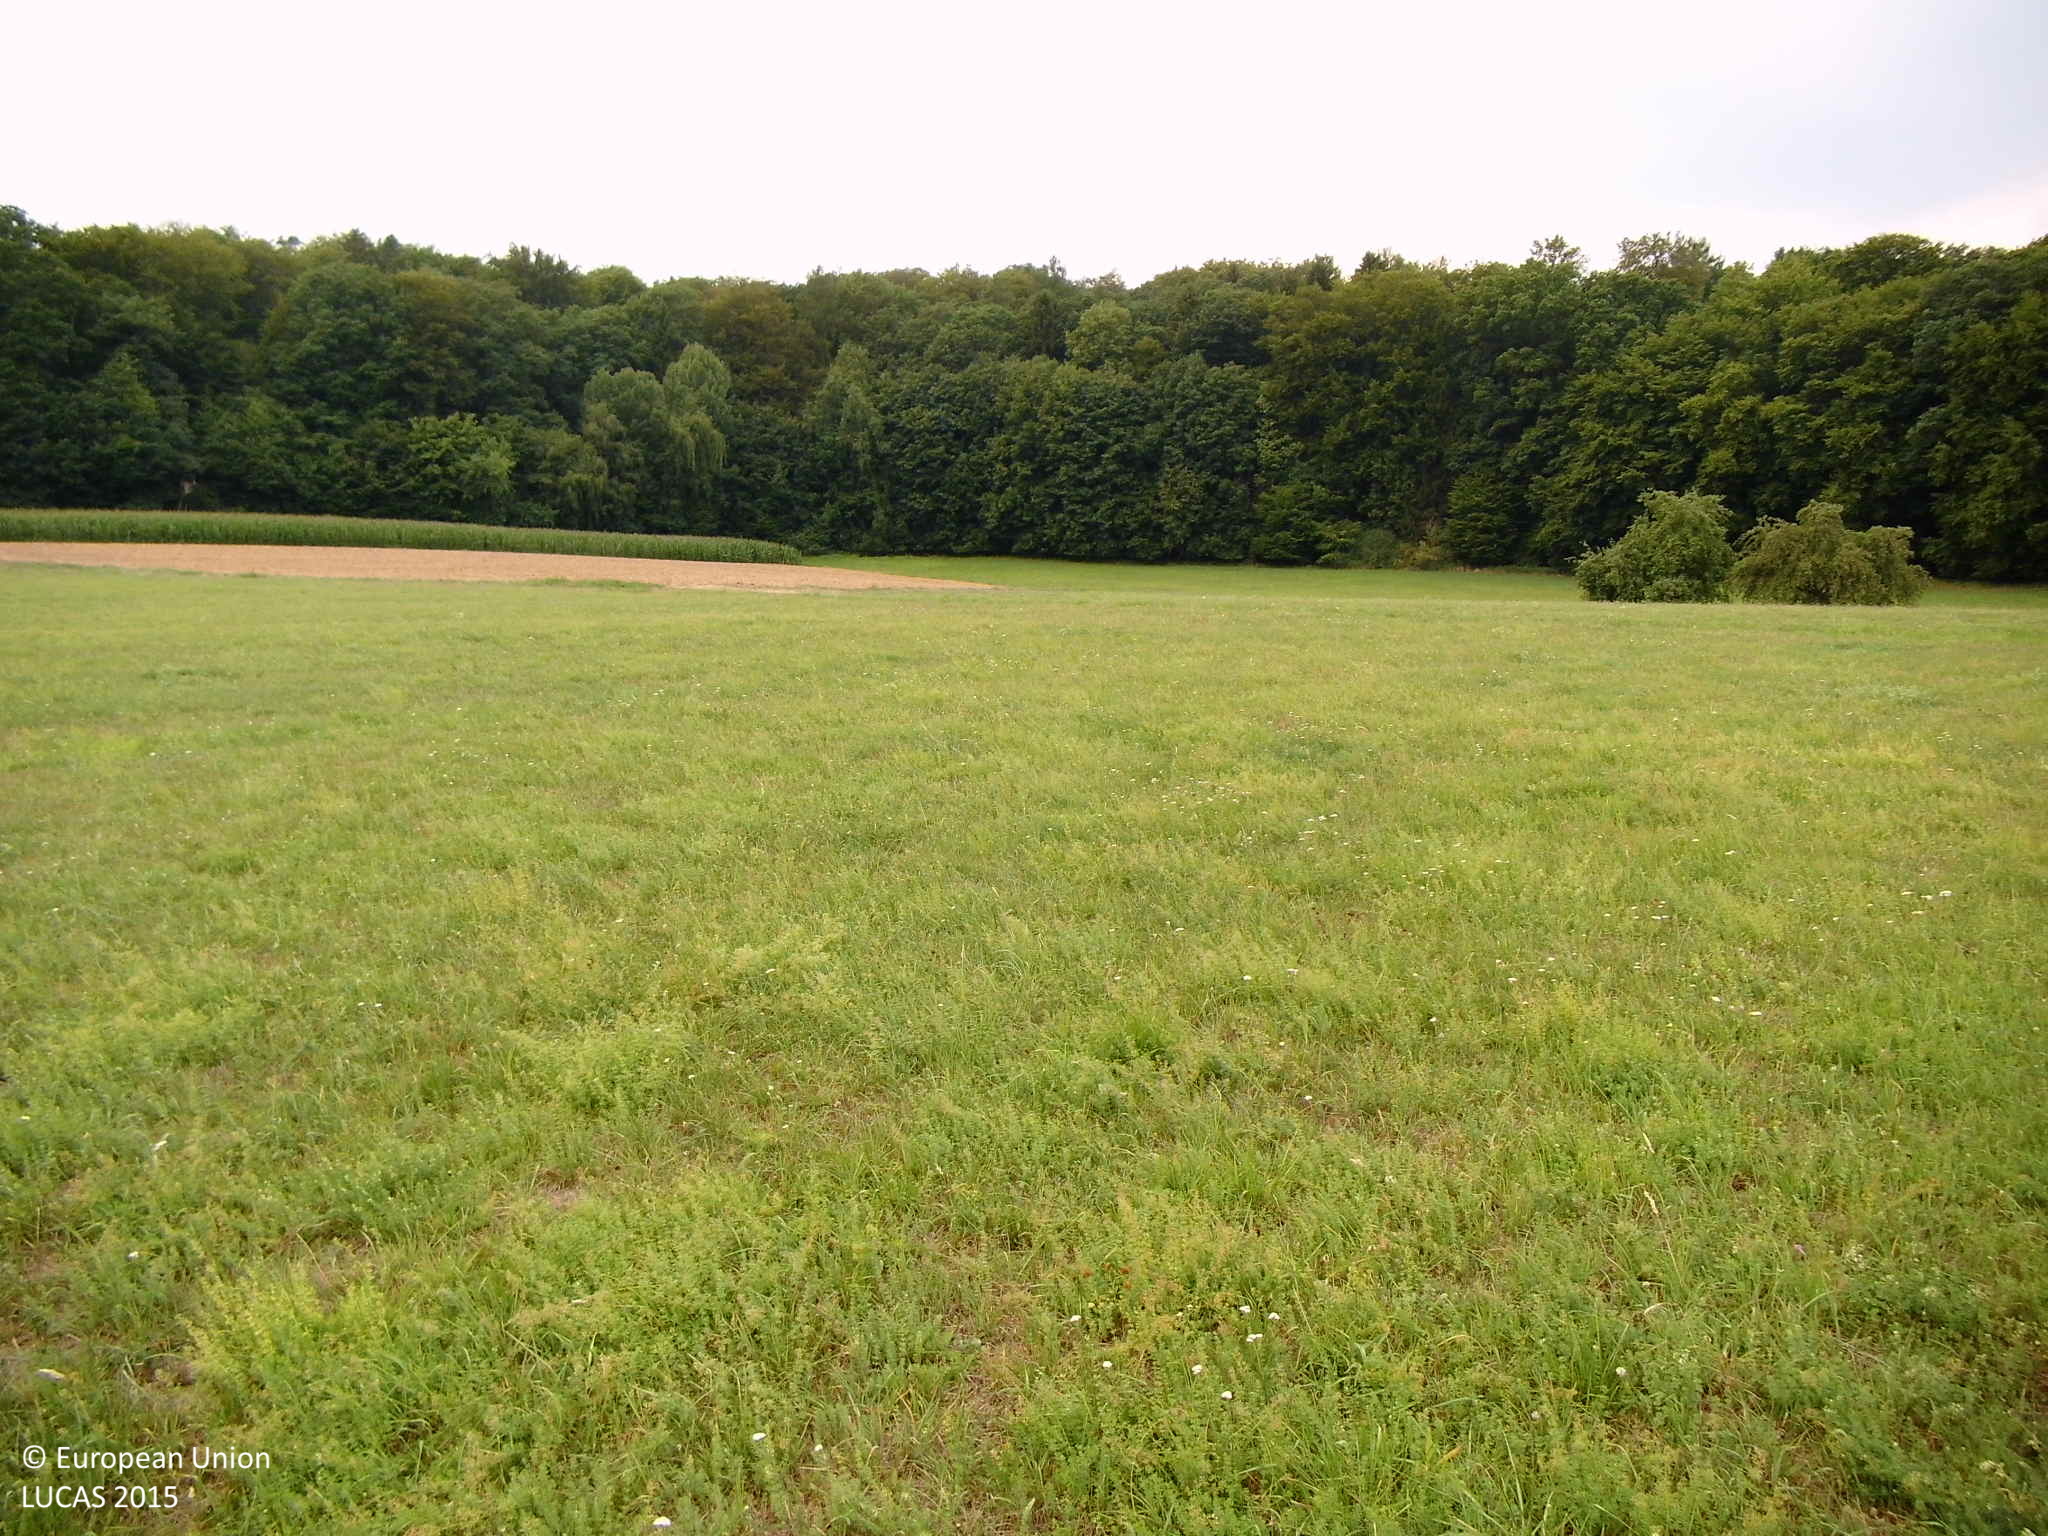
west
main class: Grassland
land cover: Grassland without tree/shrub cover
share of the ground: > 75 %
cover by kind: herbaceous plants 100 %
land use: Agriculture (excluding fallow land and kitchen gardens)
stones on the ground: < 10 %
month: August
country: DE
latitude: 50.6073
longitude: 8.6014
